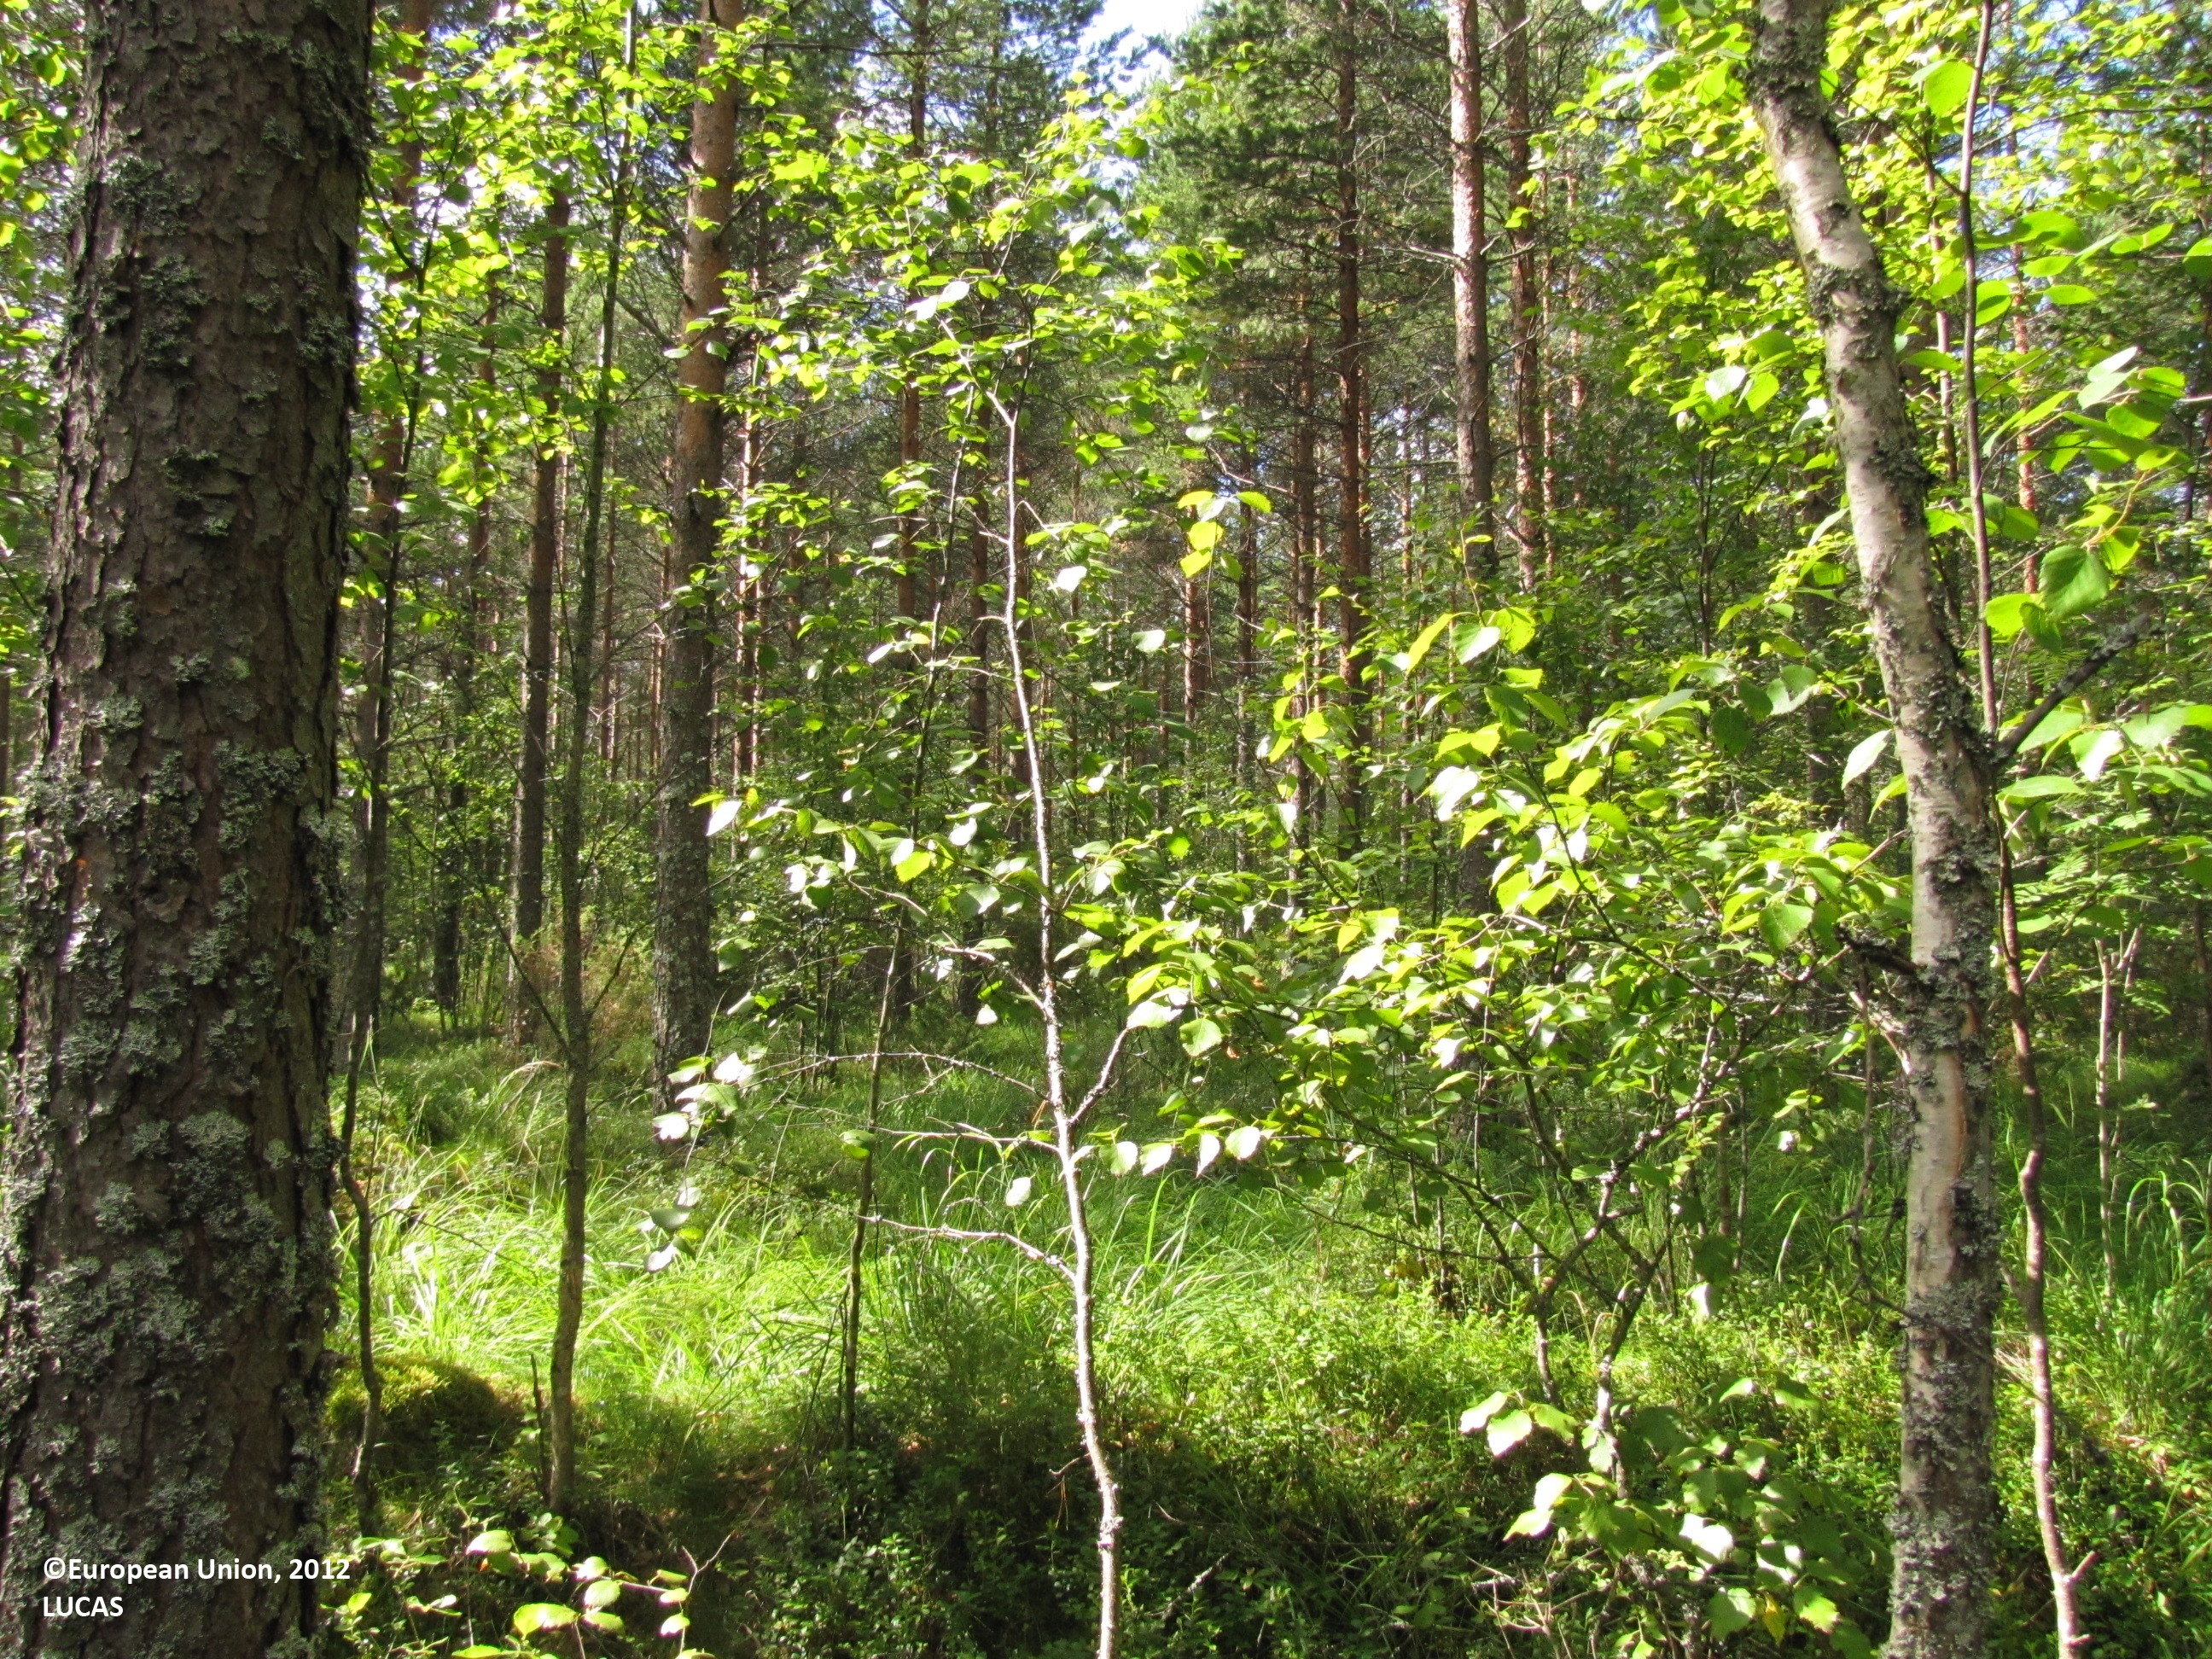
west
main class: Woodland
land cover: Pine dominated mixed woodland
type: boreal forest
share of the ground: > 75 %
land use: Forestry
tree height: > 5 m
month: August
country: FI
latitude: 61.7268
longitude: 22.8794
